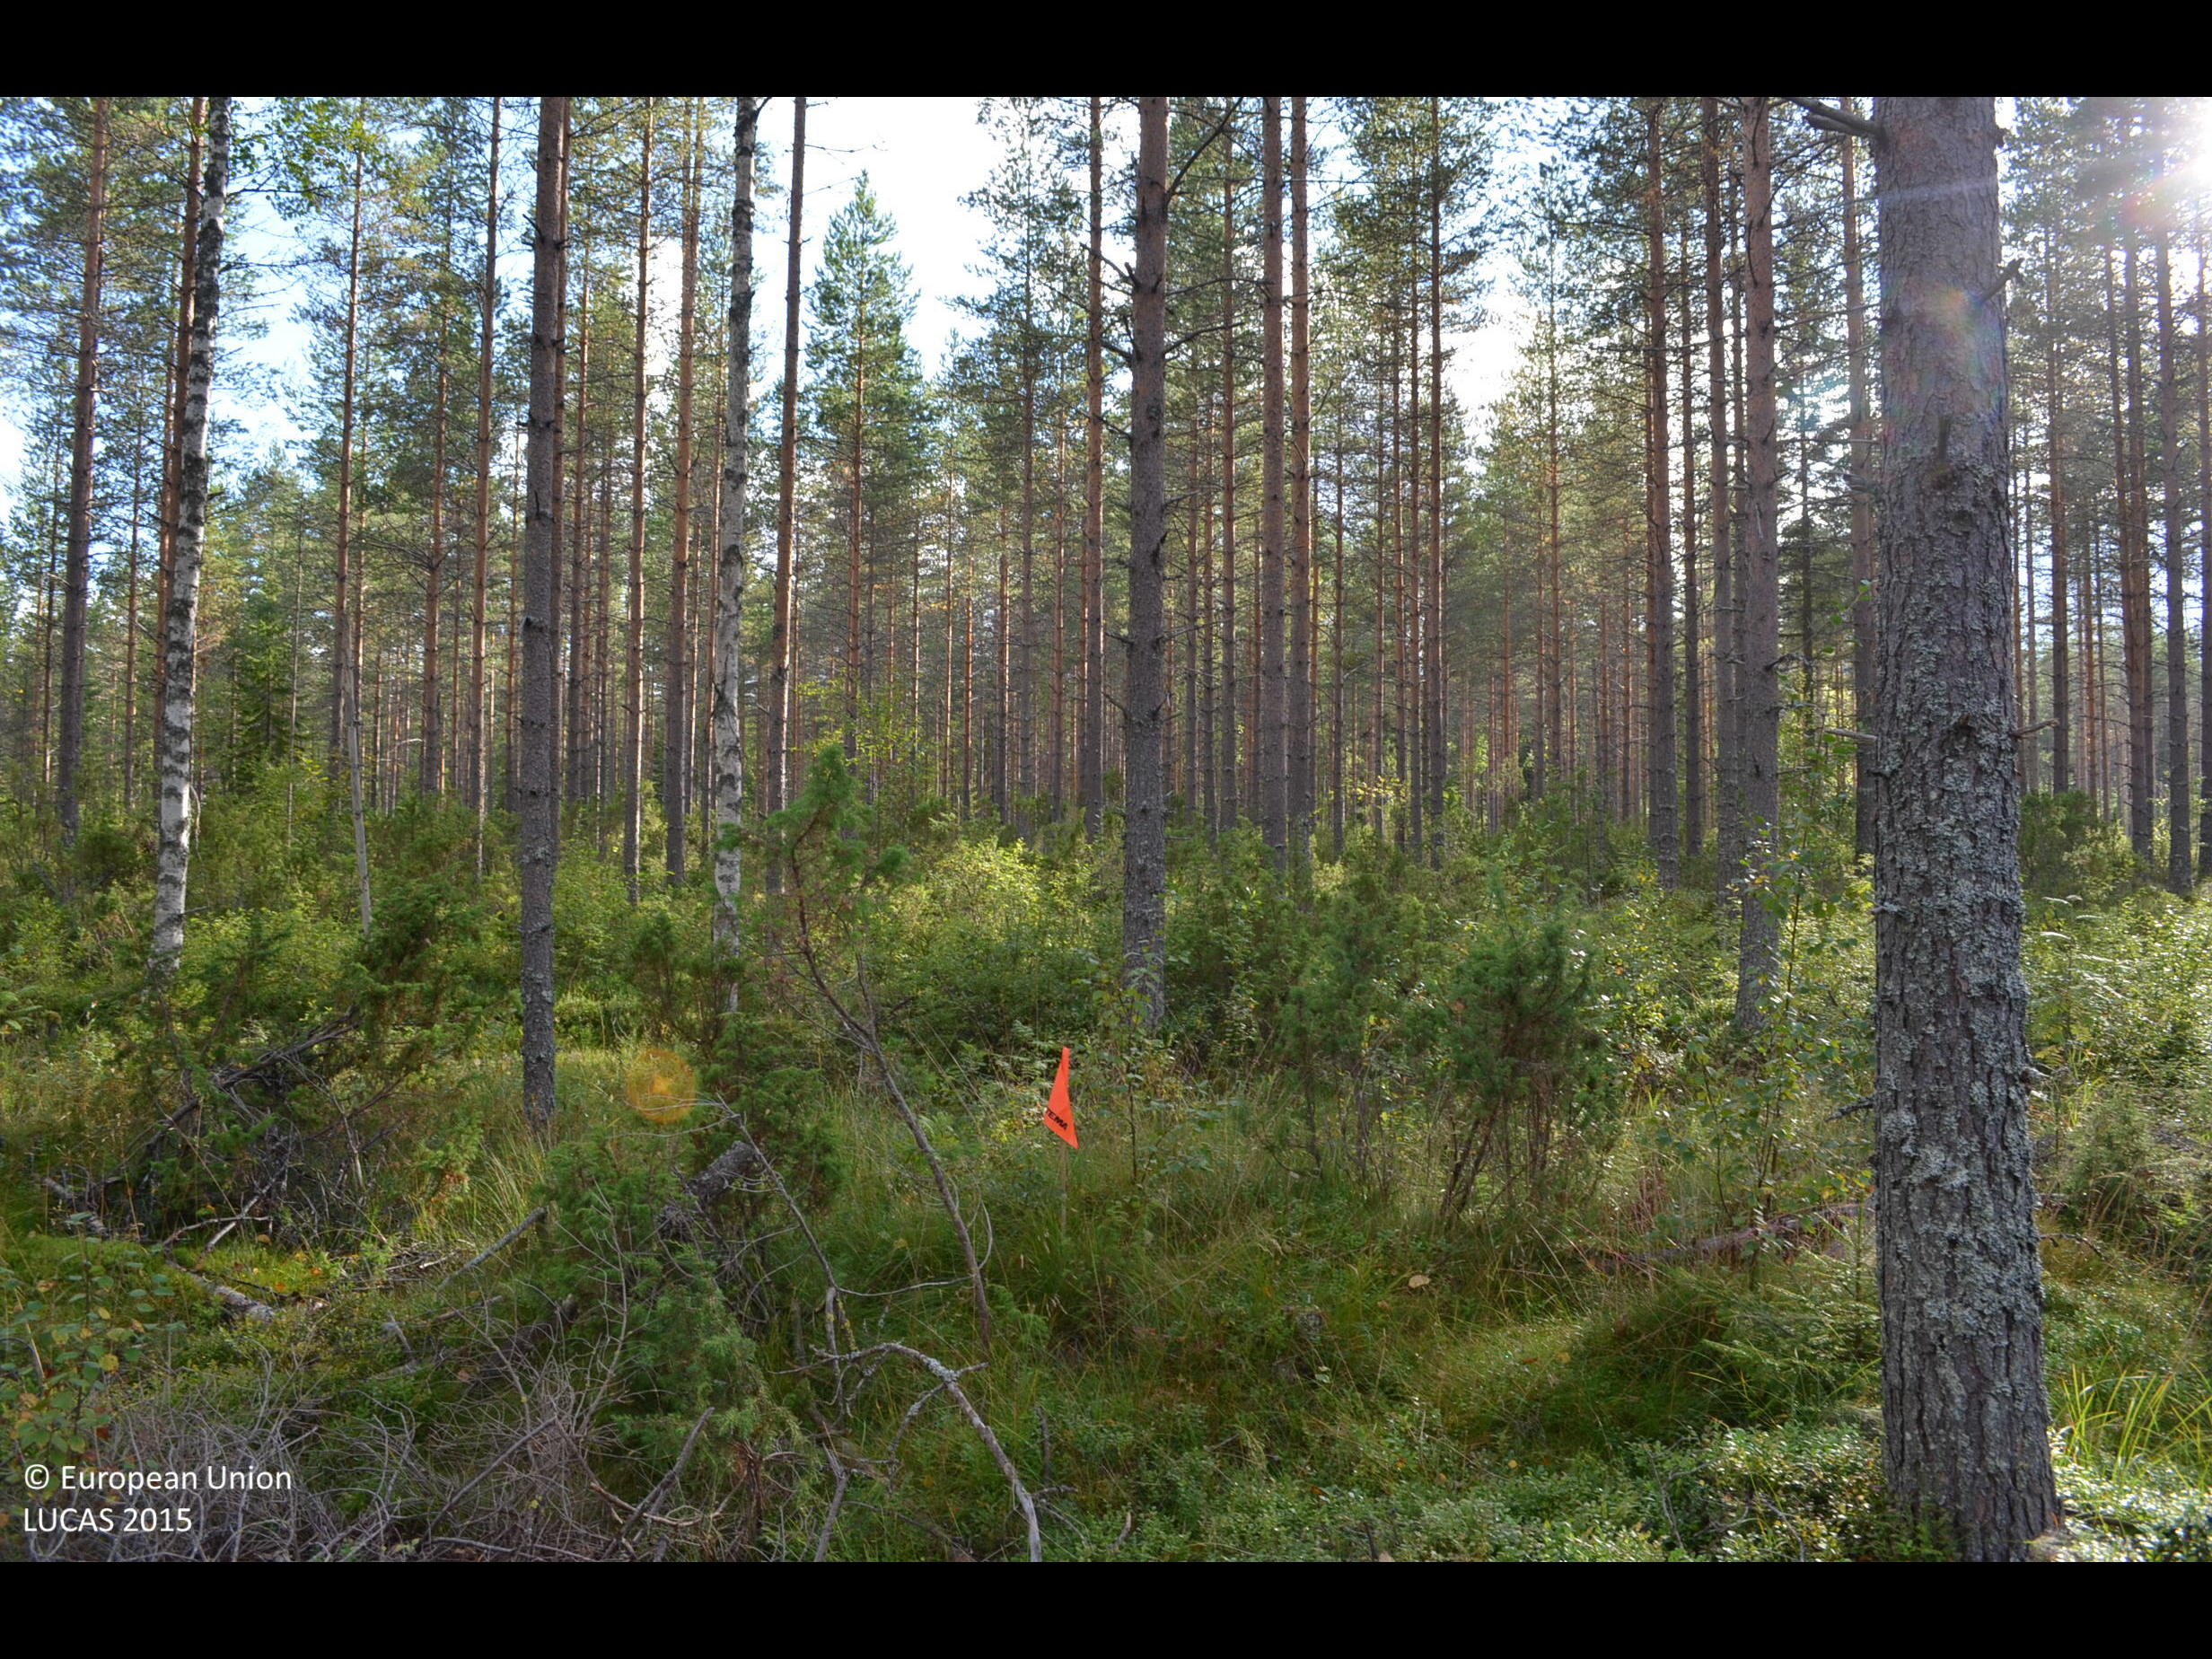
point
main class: Woodland
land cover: Pine dominated mixed woodland
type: boreal forest
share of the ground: 50 - 75 %
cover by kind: coniferous forest trees 40 %, broadleaved forest trees 25 %, shrubs 25 %, herbaceous plants 5 %
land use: Forestry
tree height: > 5 m
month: August
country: FI
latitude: 62.6972
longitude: 24.4898
